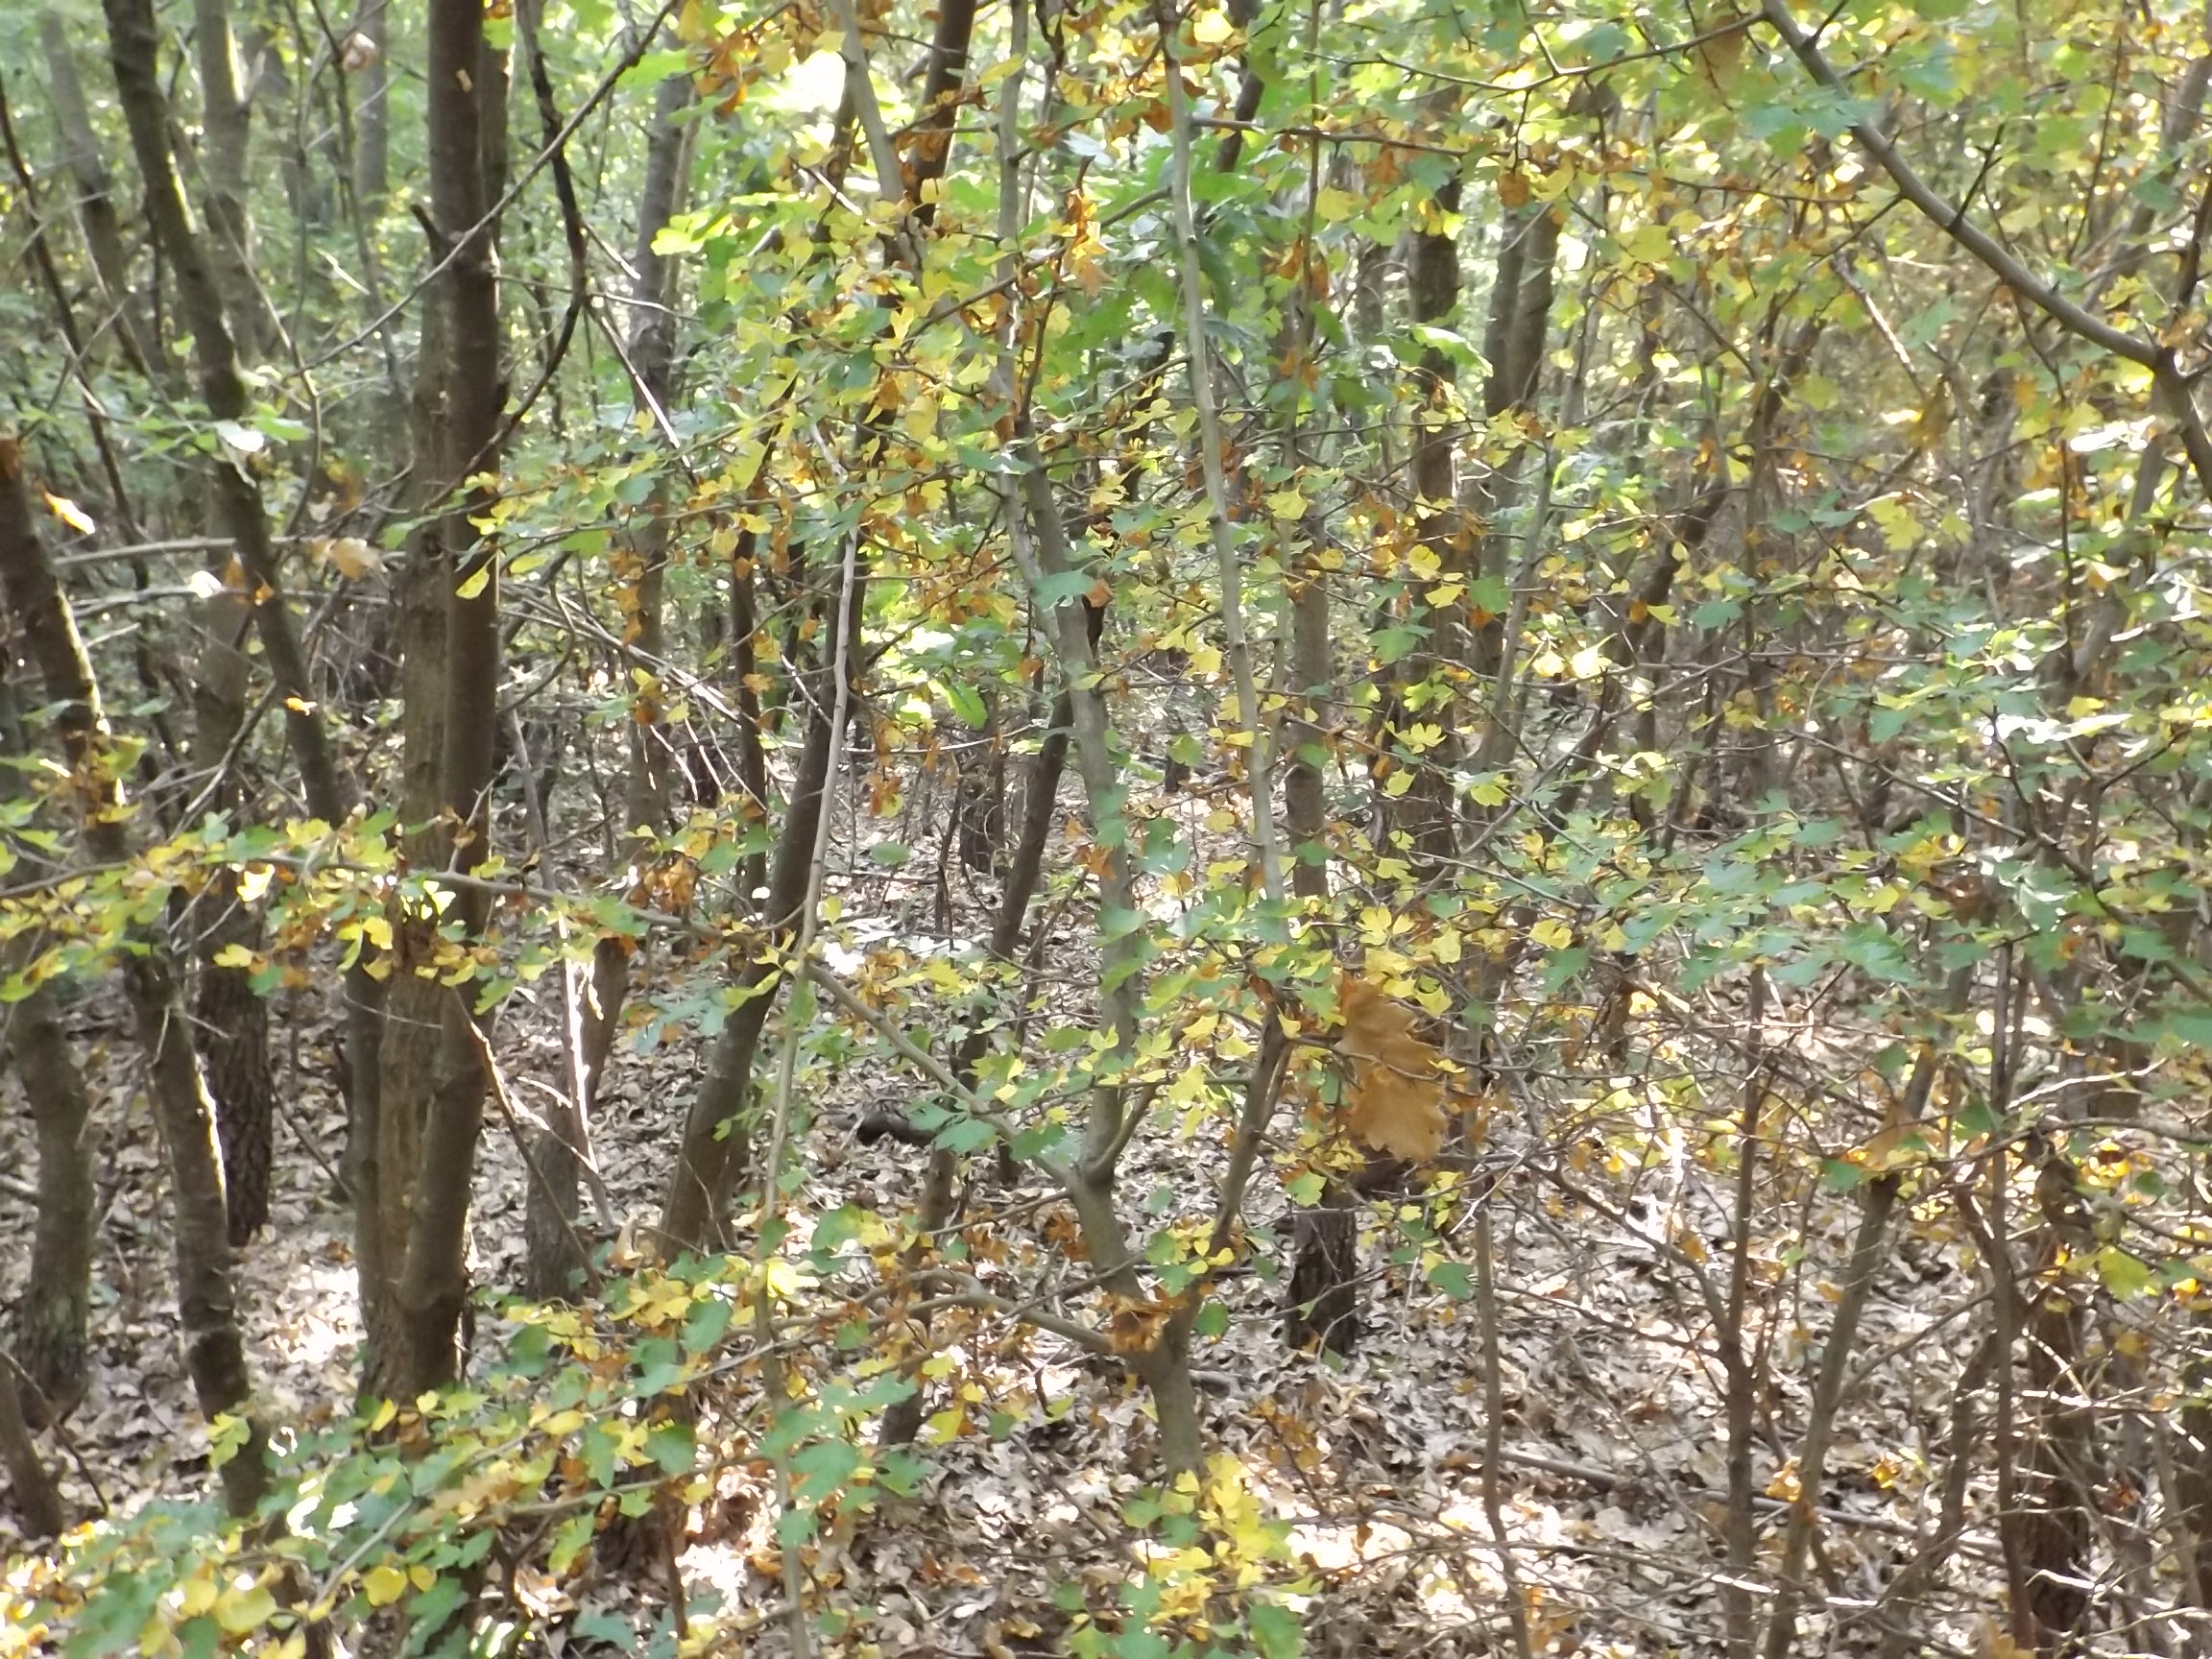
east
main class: Woodland
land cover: Broadleaved woodland
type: mesophytic deciduous forest
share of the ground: > 75 %
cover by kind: broadleaved forest trees 95 %, herbaceous plants 5 %
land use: Forestry
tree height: > 5 m
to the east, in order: Broadleaved woodland
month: July
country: BG
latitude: 43.4790
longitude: 27.3739
